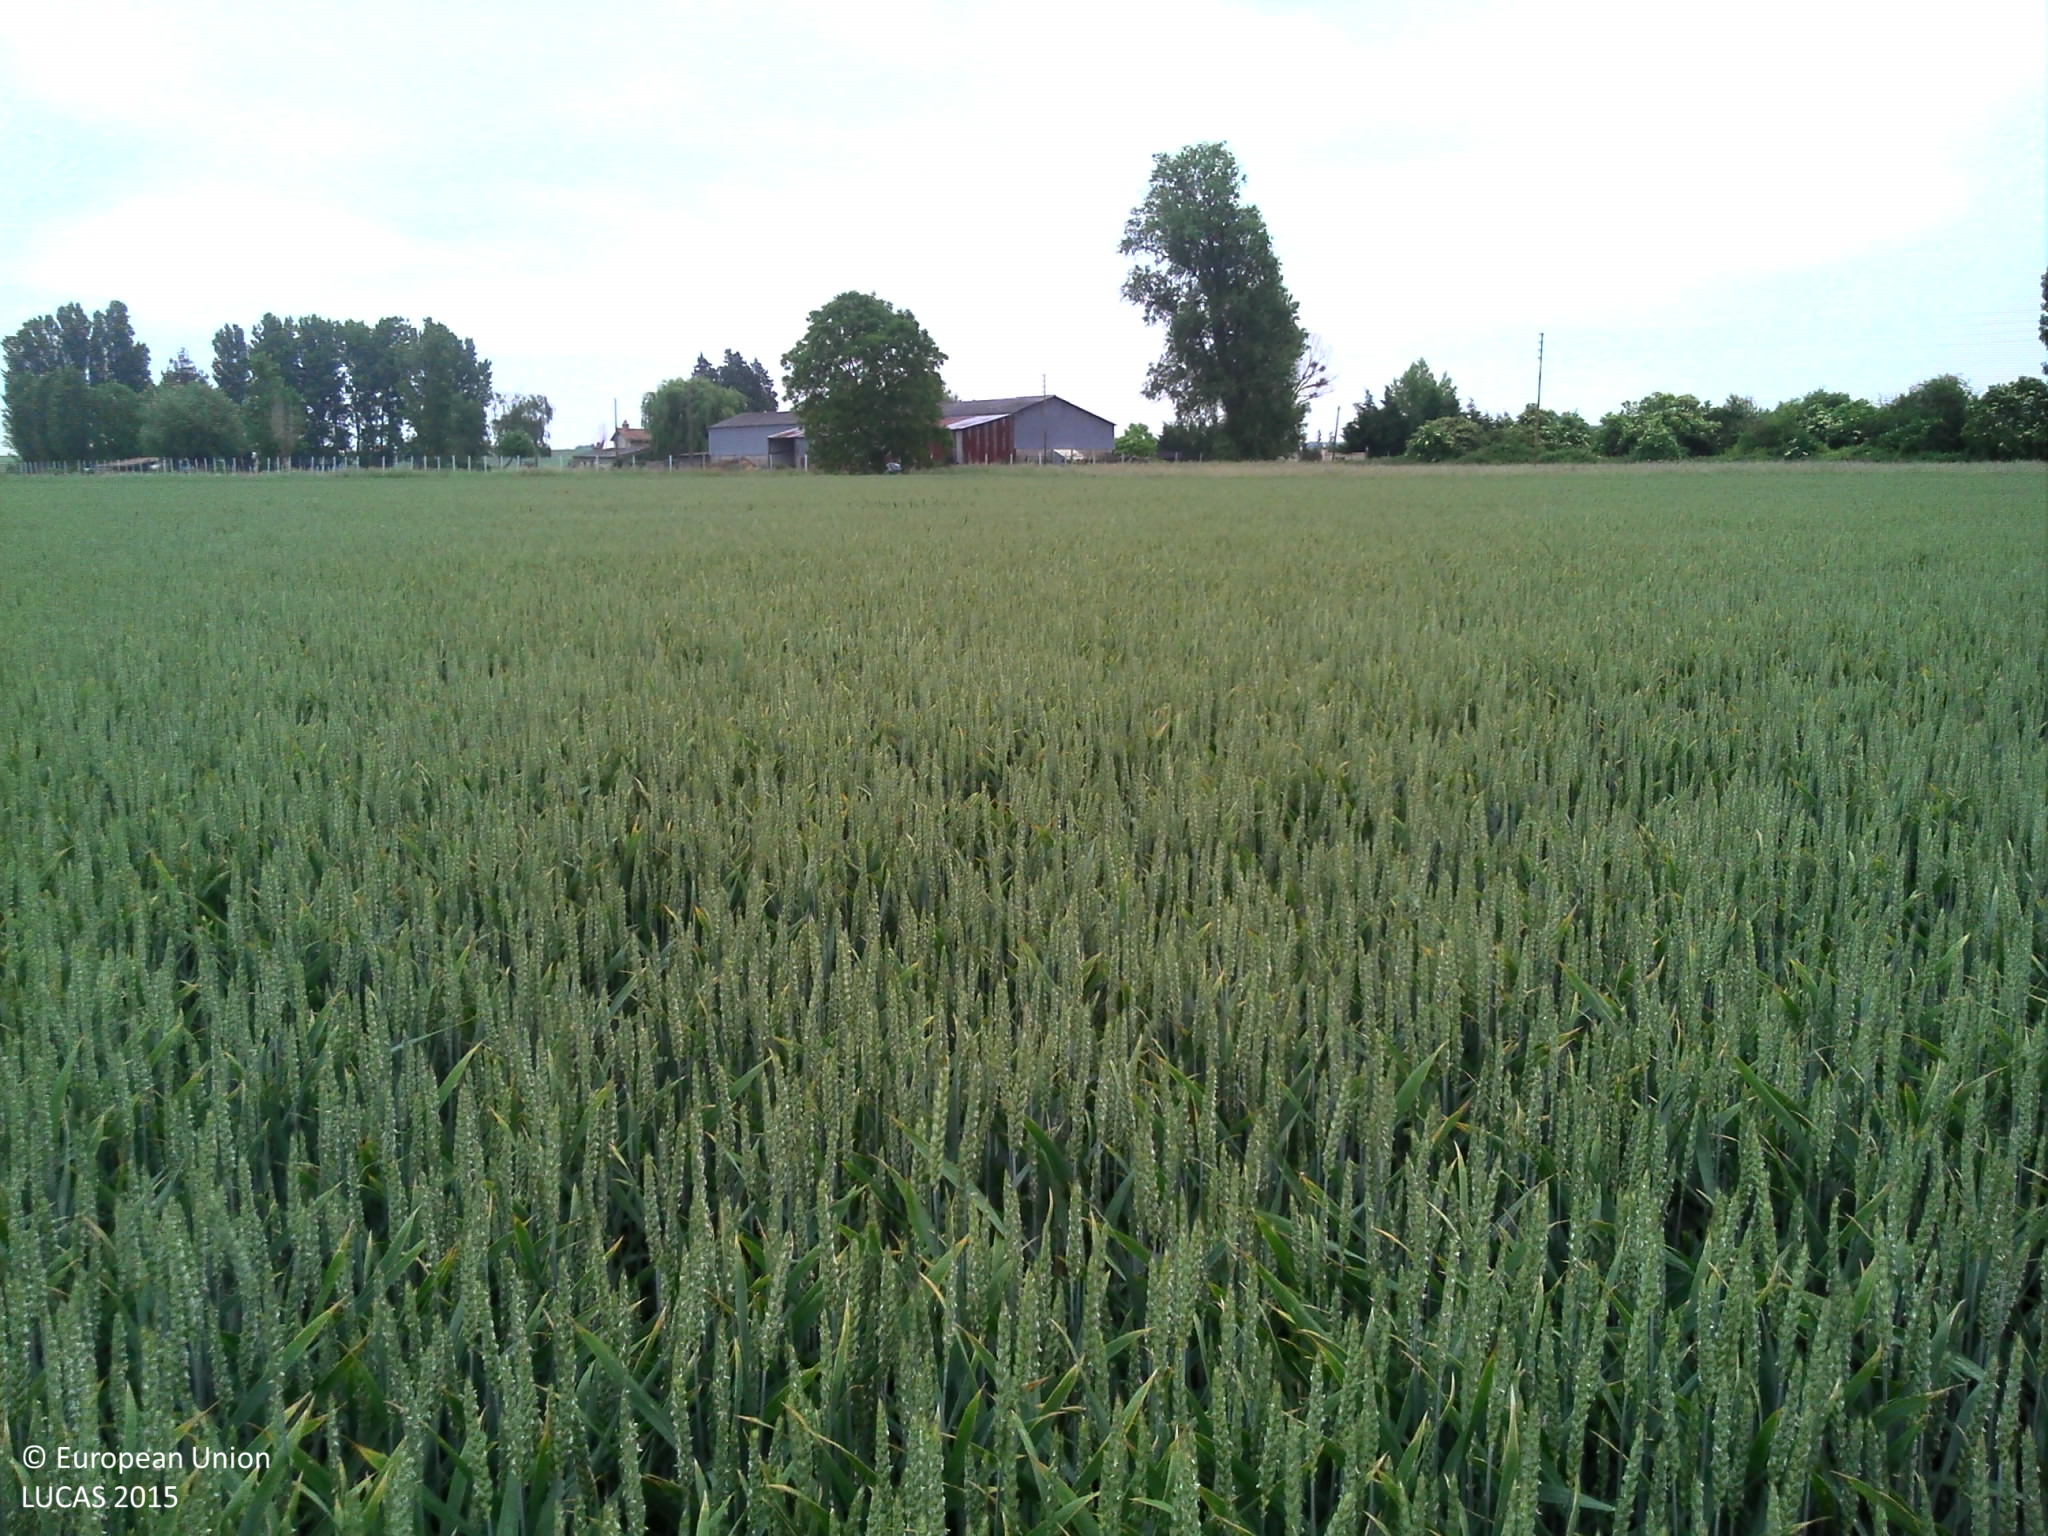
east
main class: Cropland
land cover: Common wheat
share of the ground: > 75 %
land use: Agriculture (excluding fallow land and kitchen gardens)
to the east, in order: Common wheat; Grassland without tree/shrub cover; Ditches and canals; Artificial constructions in urban areas
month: May
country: FR
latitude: 47.0686
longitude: 0.0875
